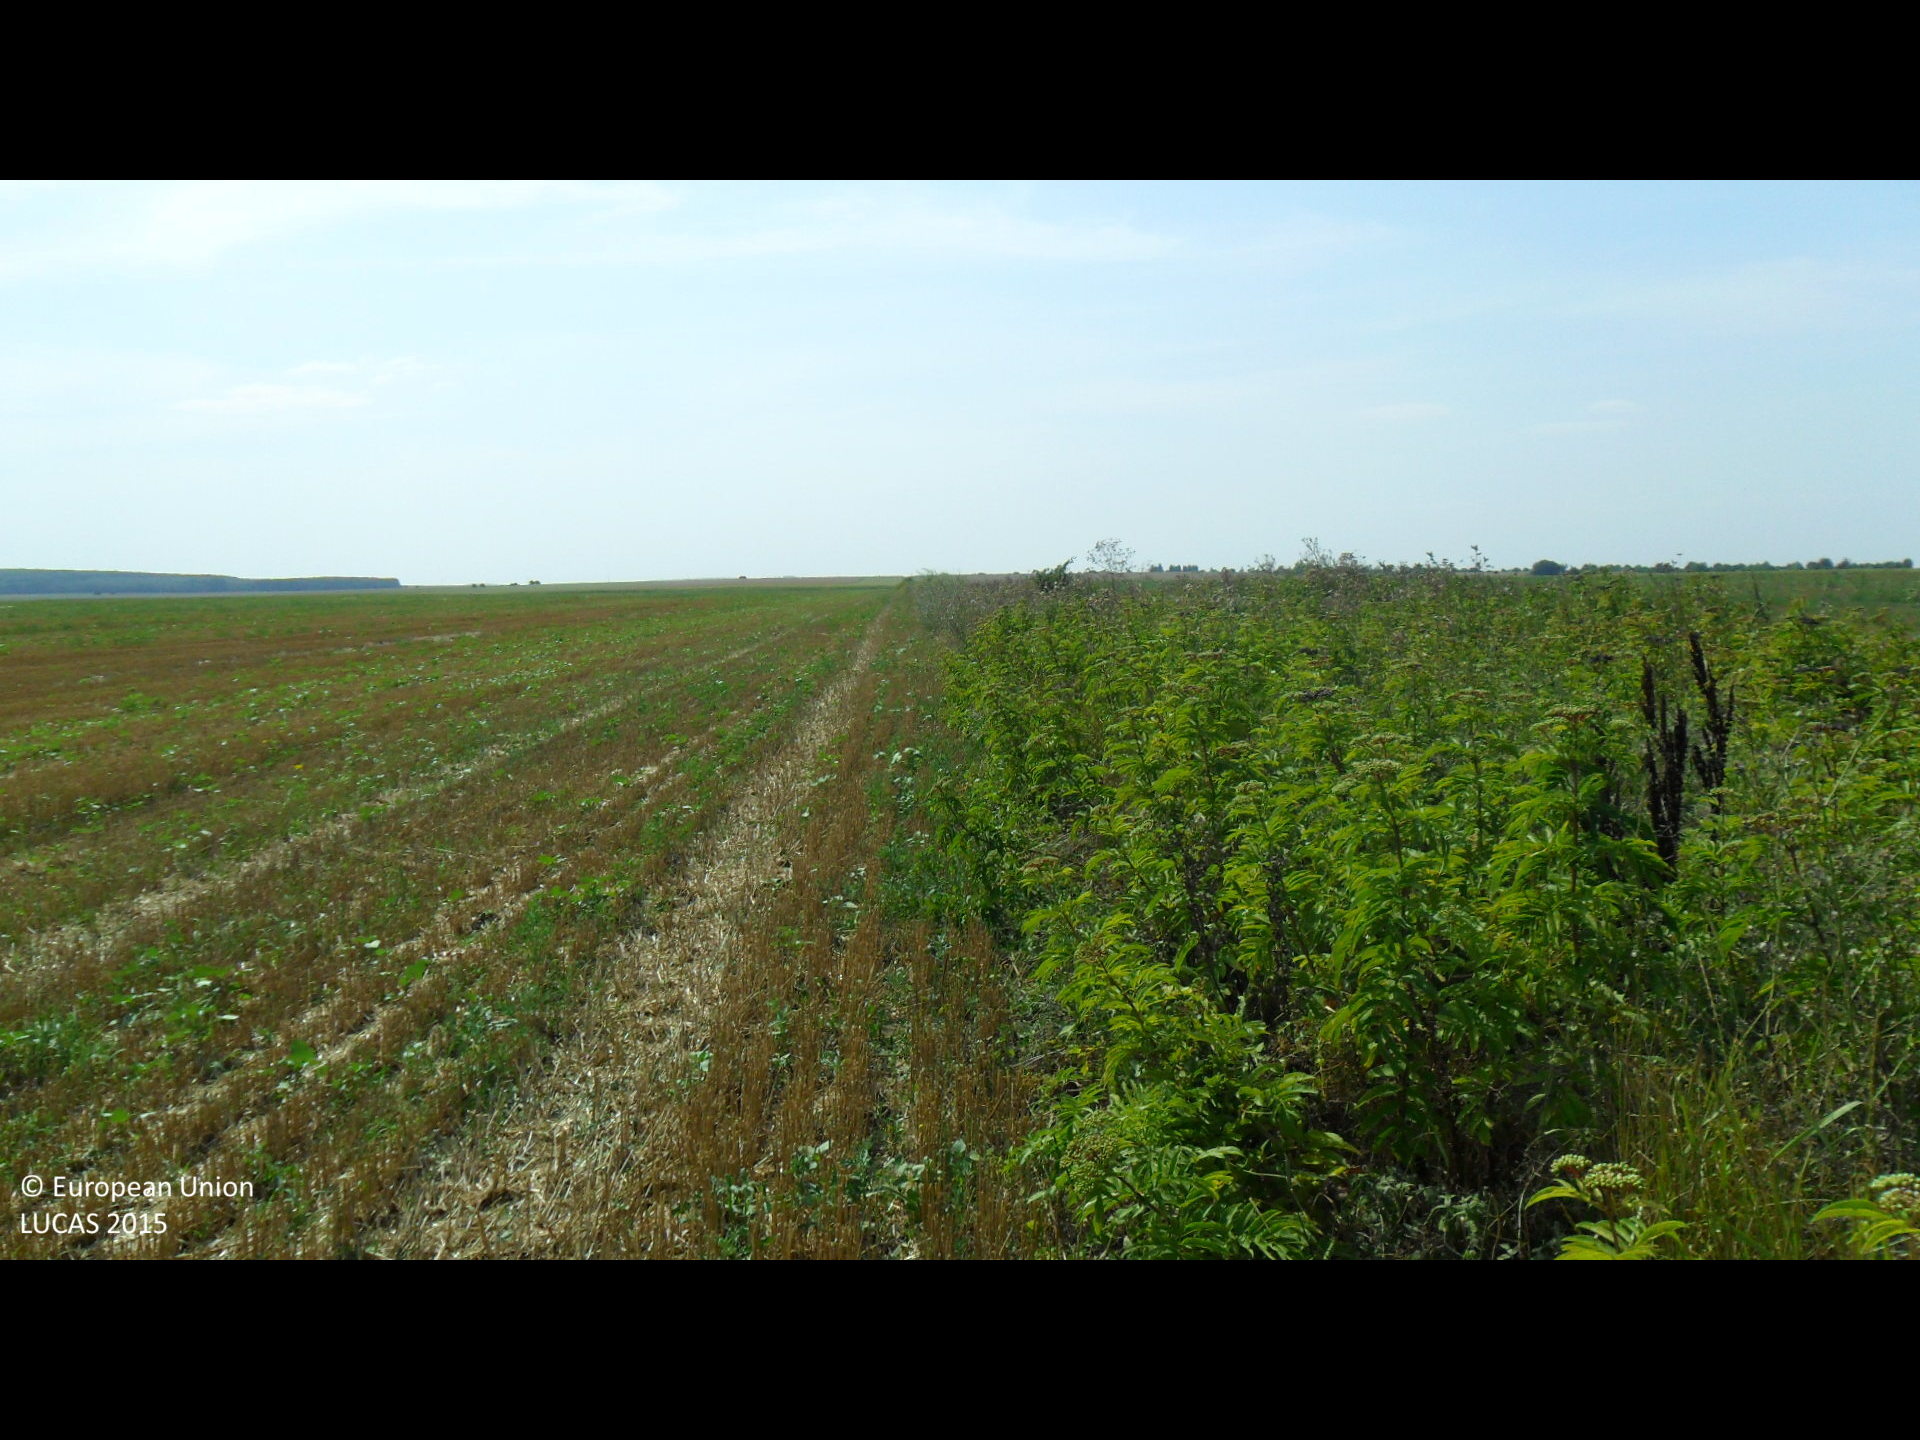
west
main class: Grassland
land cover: Spontaneously vegetated surfaces
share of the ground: > 75 %
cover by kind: herbaceous plants 100 %
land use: Semi-natural and natural areas not in use
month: August
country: BG
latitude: 43.3147
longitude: 26.2611
